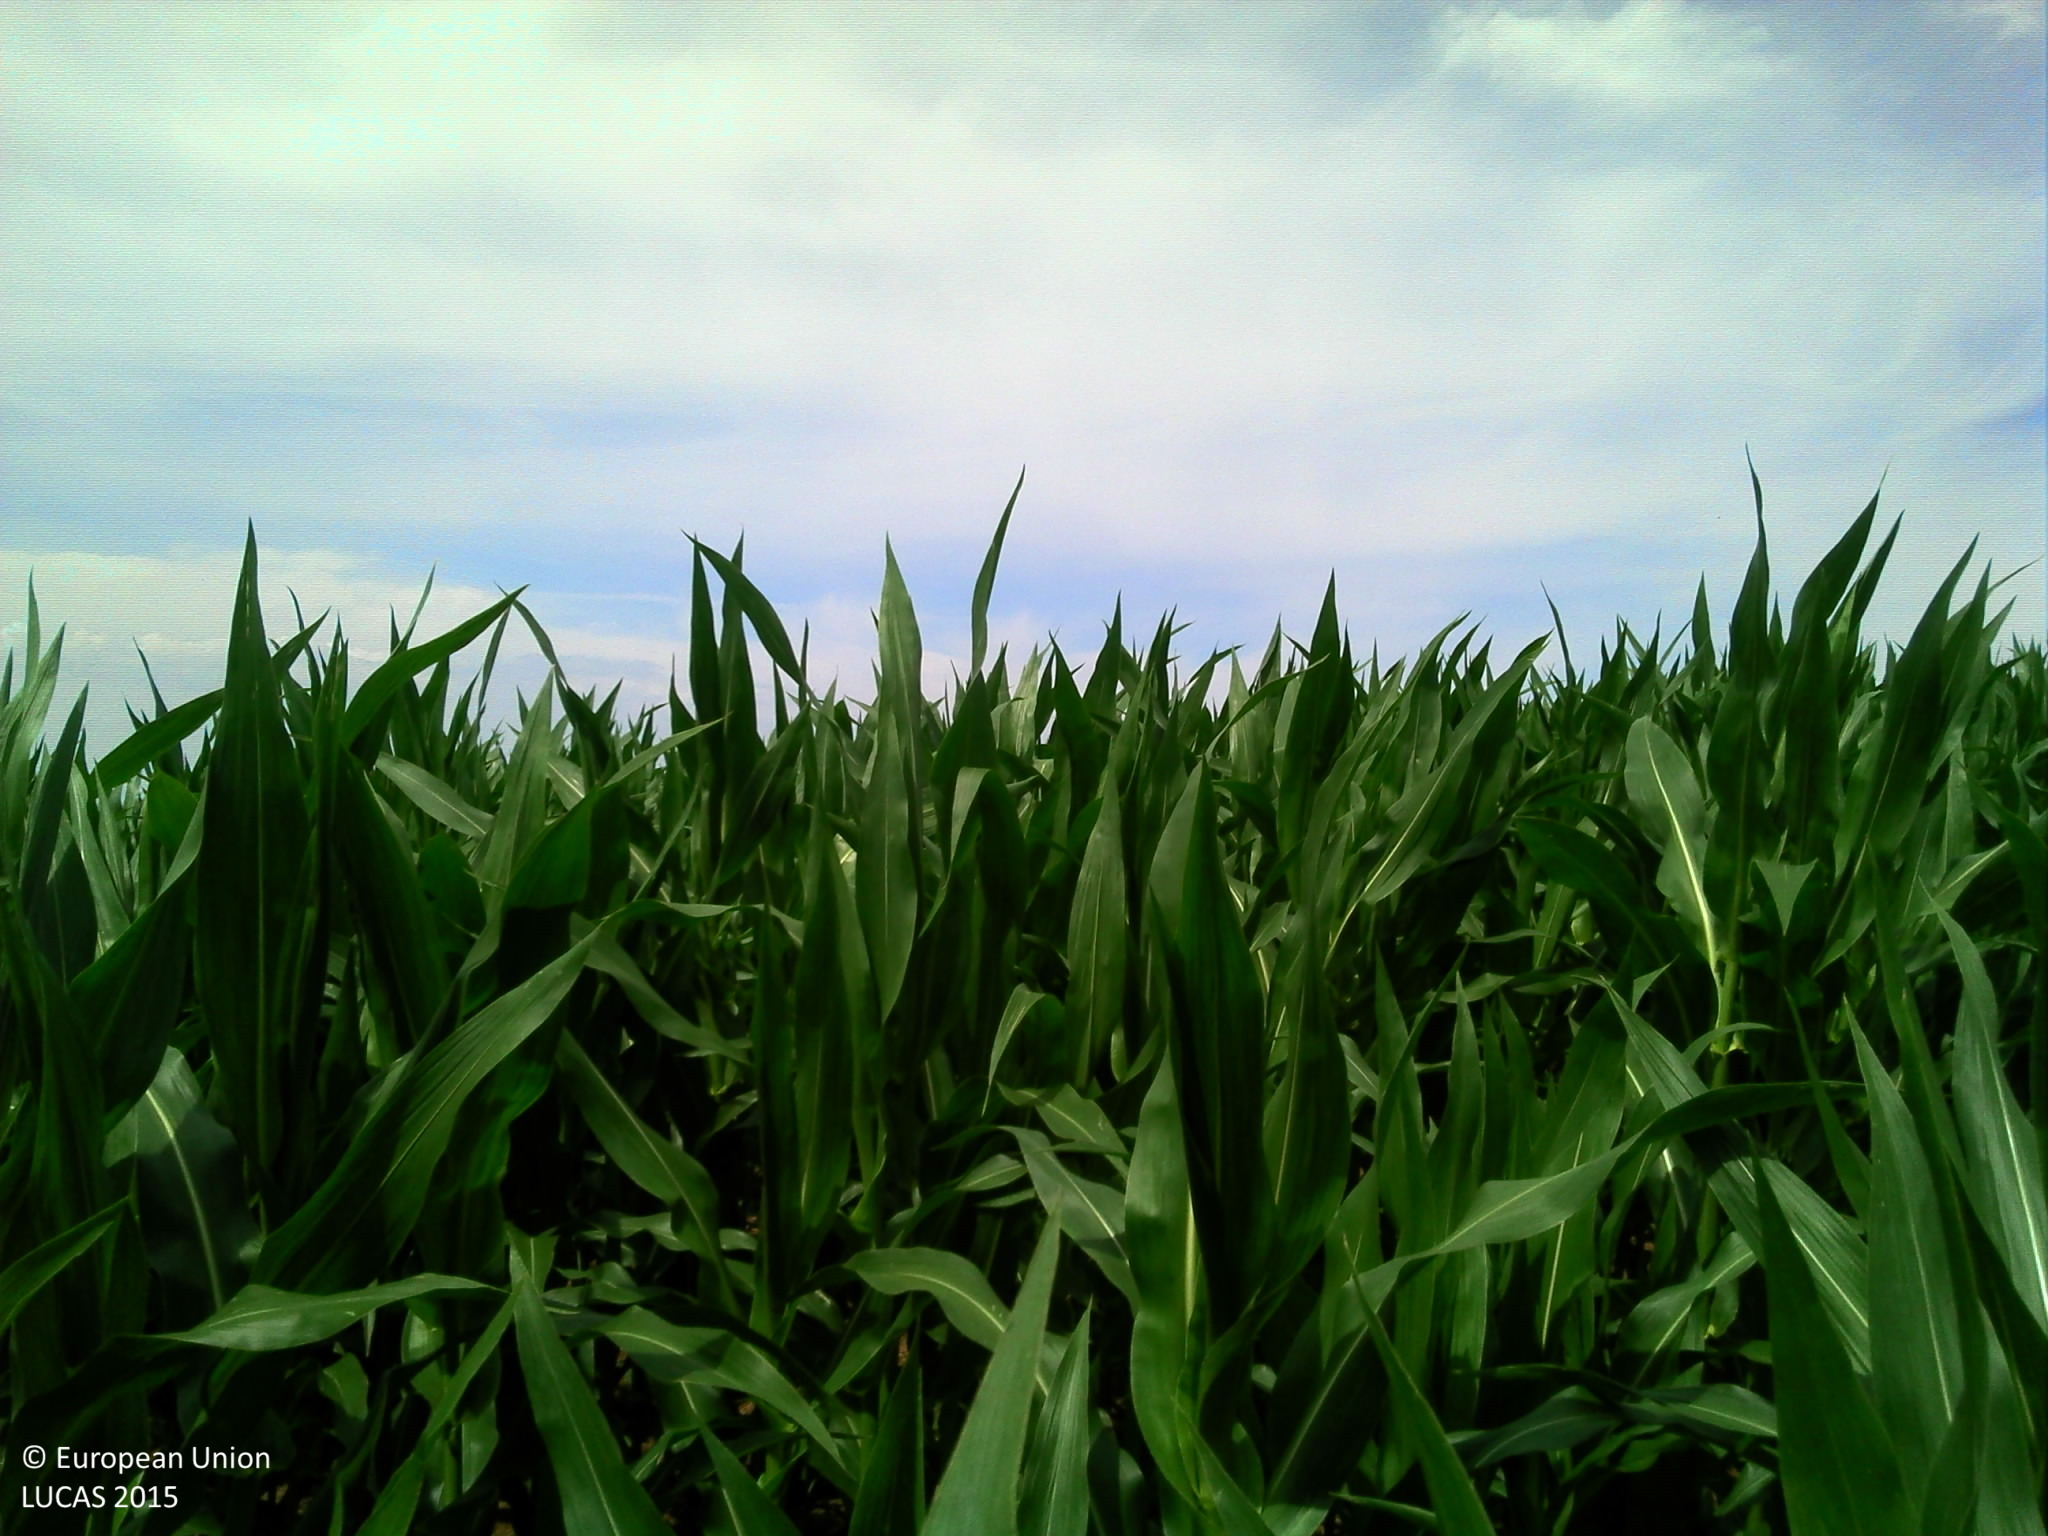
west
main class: Cropland
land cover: Maize
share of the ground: > 75 %
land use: Agriculture (excluding fallow land and kitchen gardens)
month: July
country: FR
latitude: 44.7961
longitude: 2.4036
